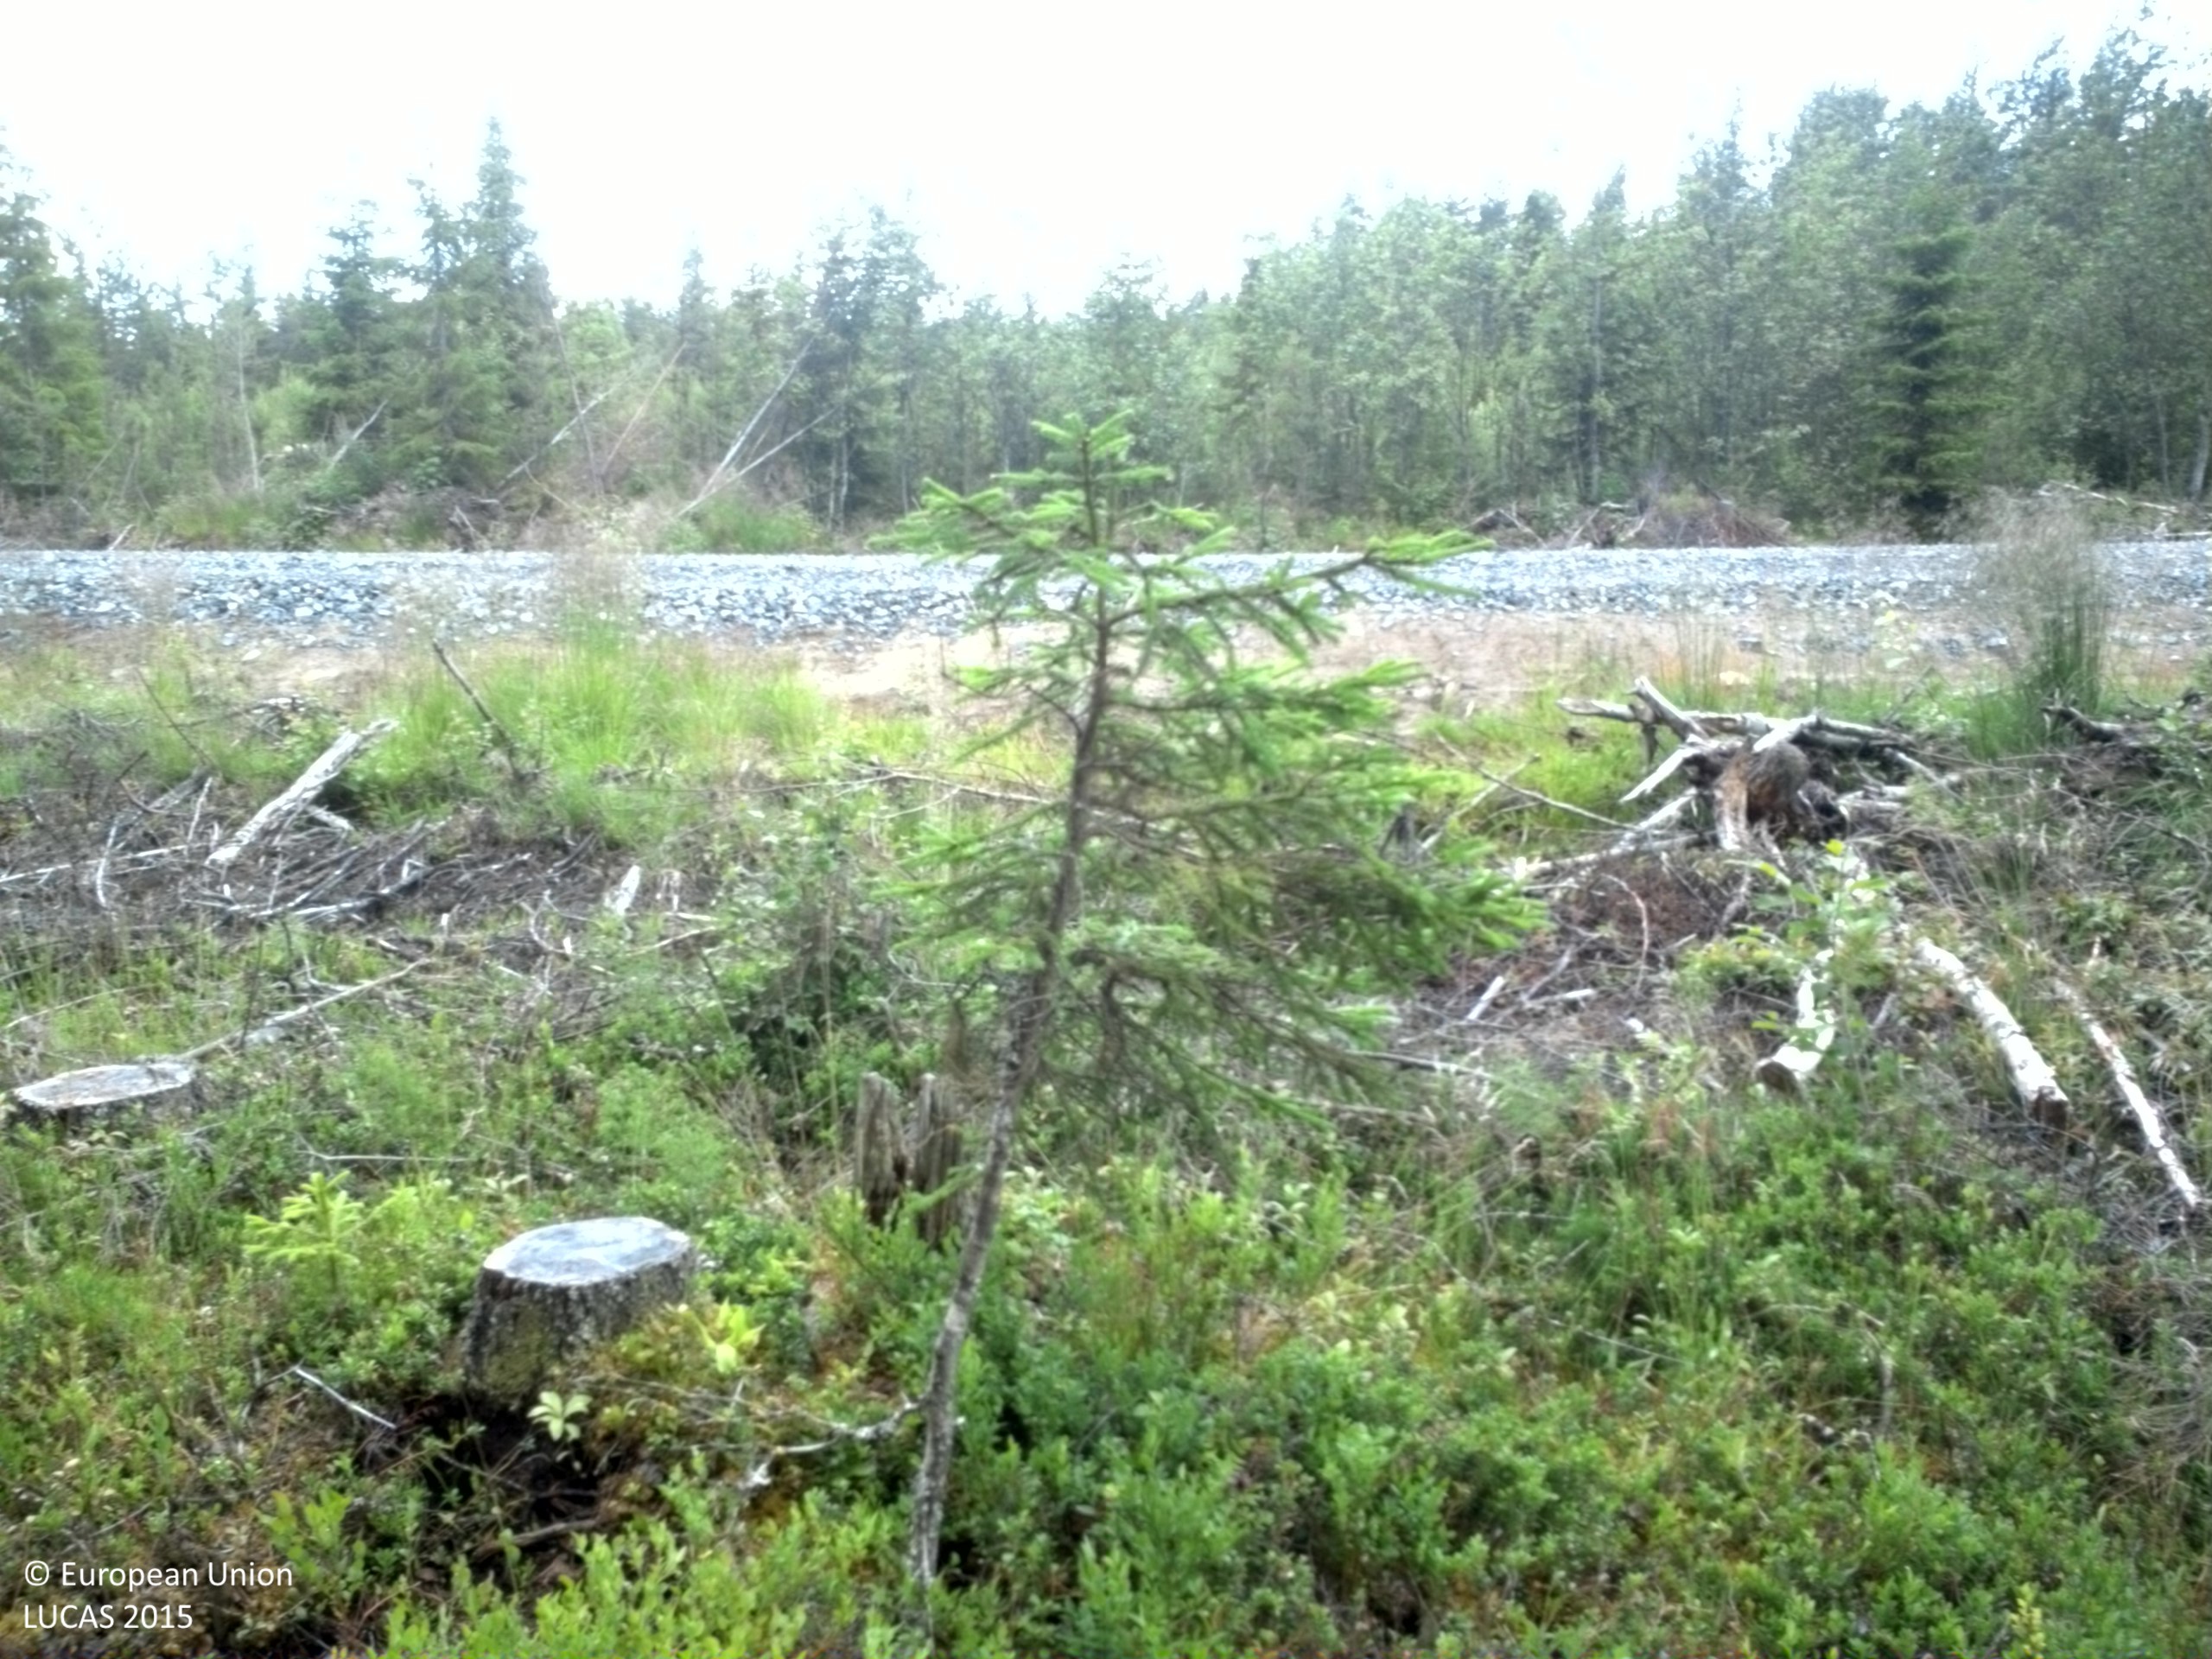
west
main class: Woodland
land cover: Spruce dominated coniferous woodland
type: boreal forest
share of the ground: 50 - 75 %
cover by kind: coniferous forest trees 65 %, shrubs 30 %, broadleaved forest trees 5 %
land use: Forestry
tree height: < 5 m
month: July
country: SE
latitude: 63.1766
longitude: 17.7033
